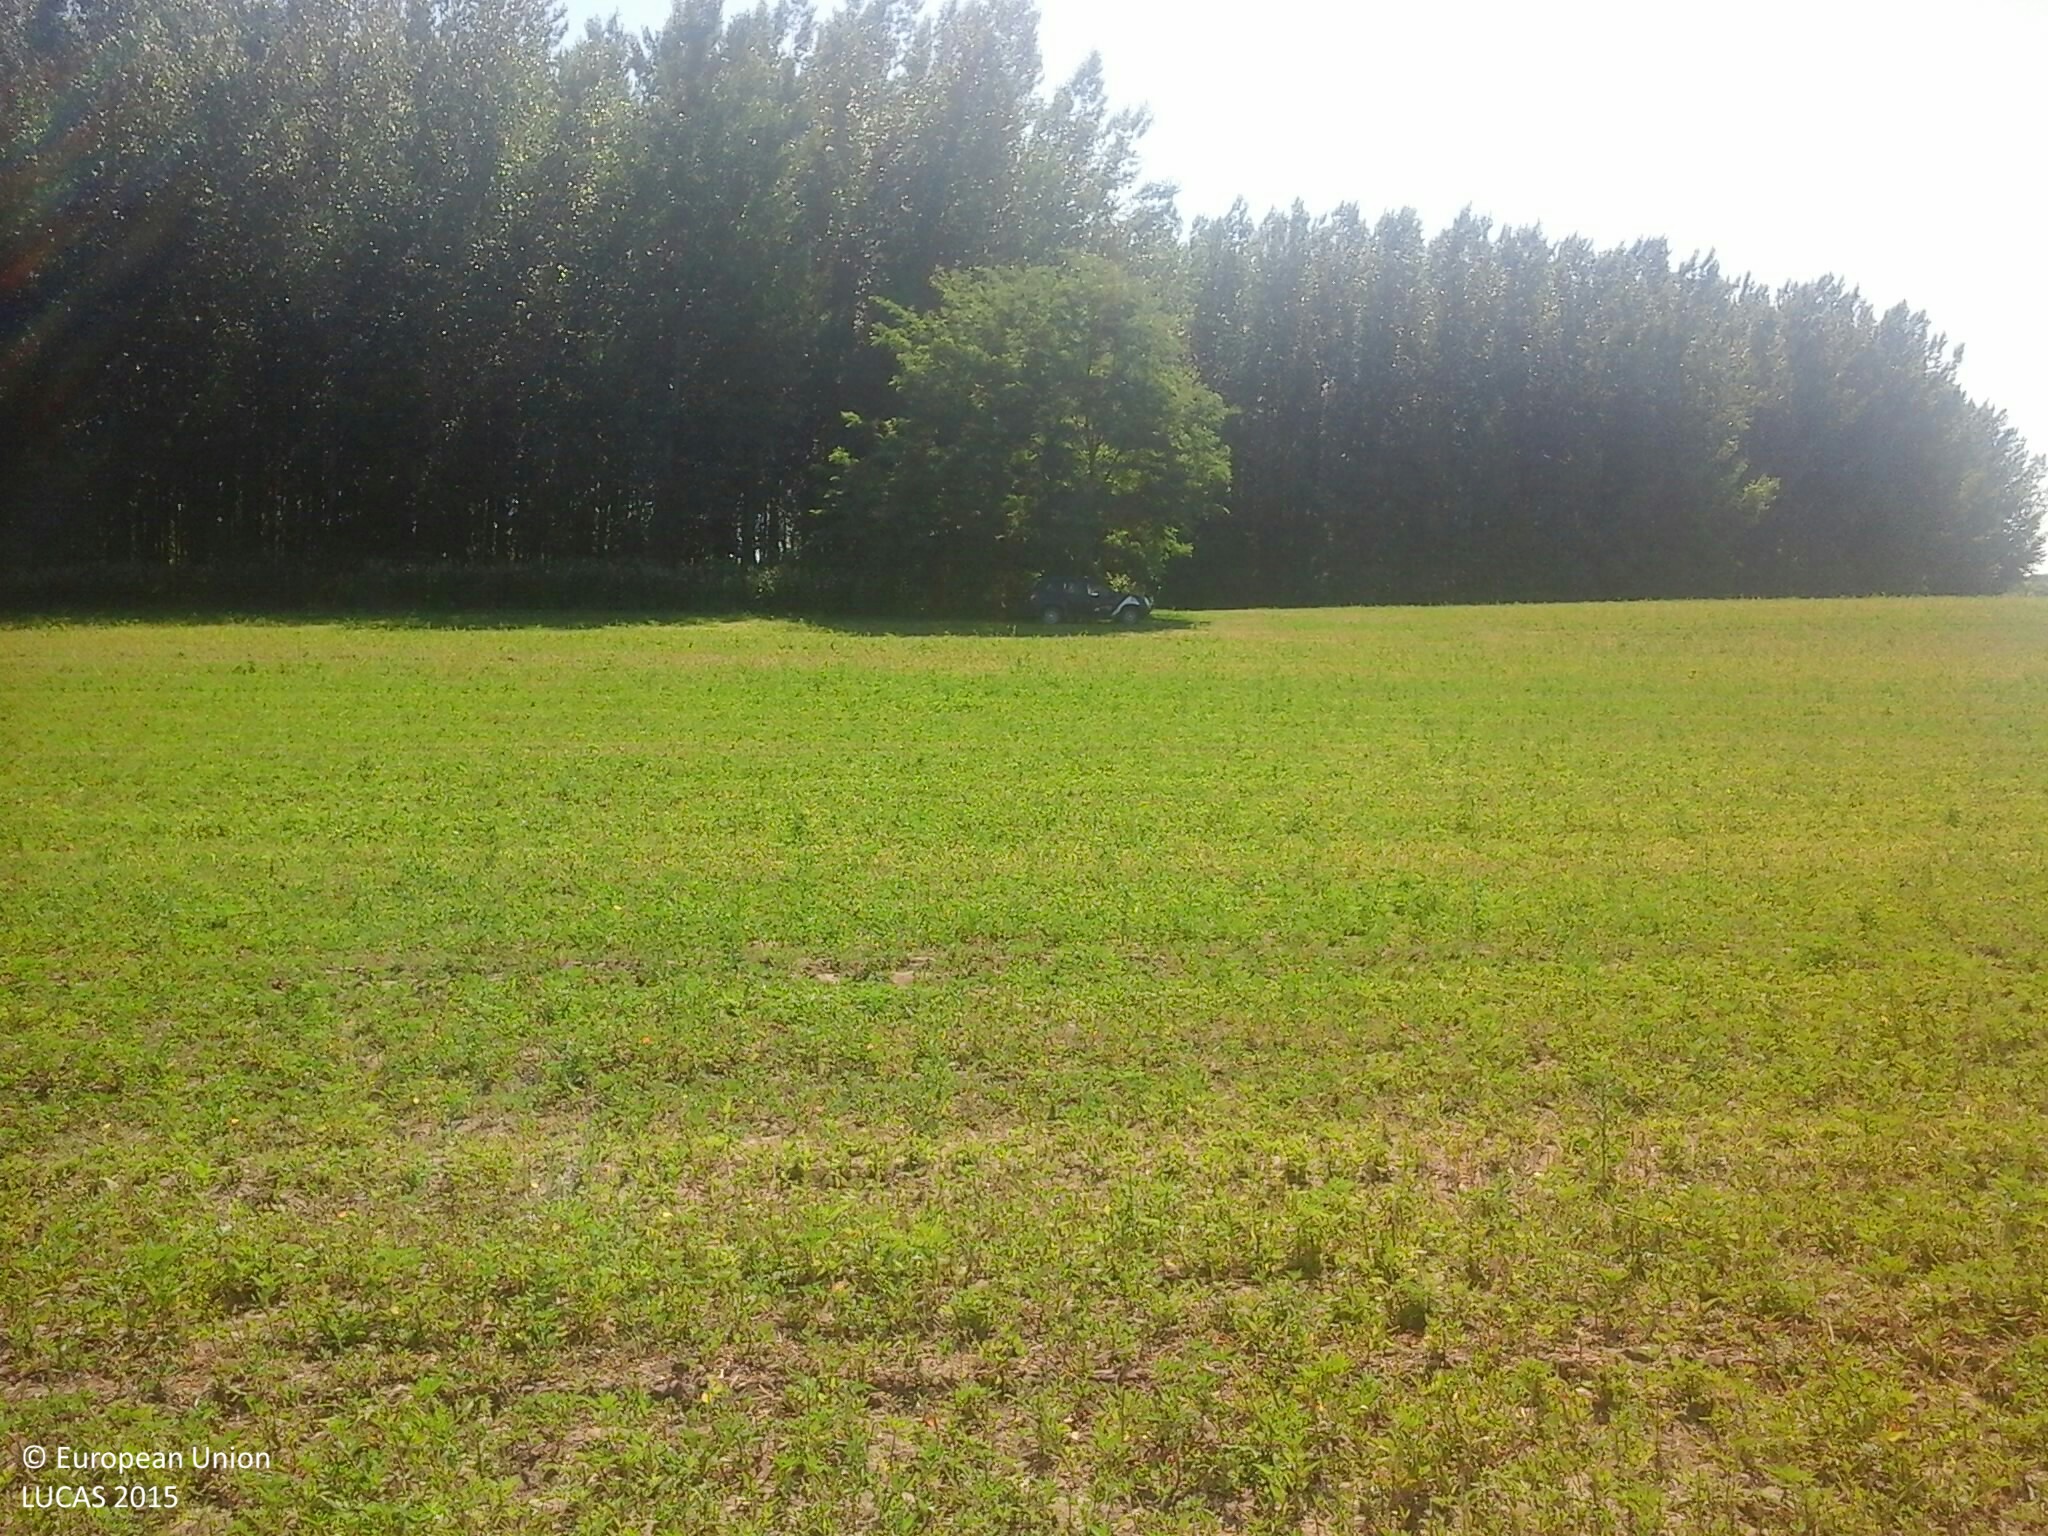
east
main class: Cropland
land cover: Lucerne
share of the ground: > 75 %
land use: Agriculture (excluding fallow land and kitchen gardens)
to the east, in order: Lucerne; Grass margins; Broadleaved woodland; Spontaneously vegetated surfaces; Fences; Abandoned hedges; Spontaneously vegetated surfaces
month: July
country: HU
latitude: 47.8842
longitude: 21.9119
